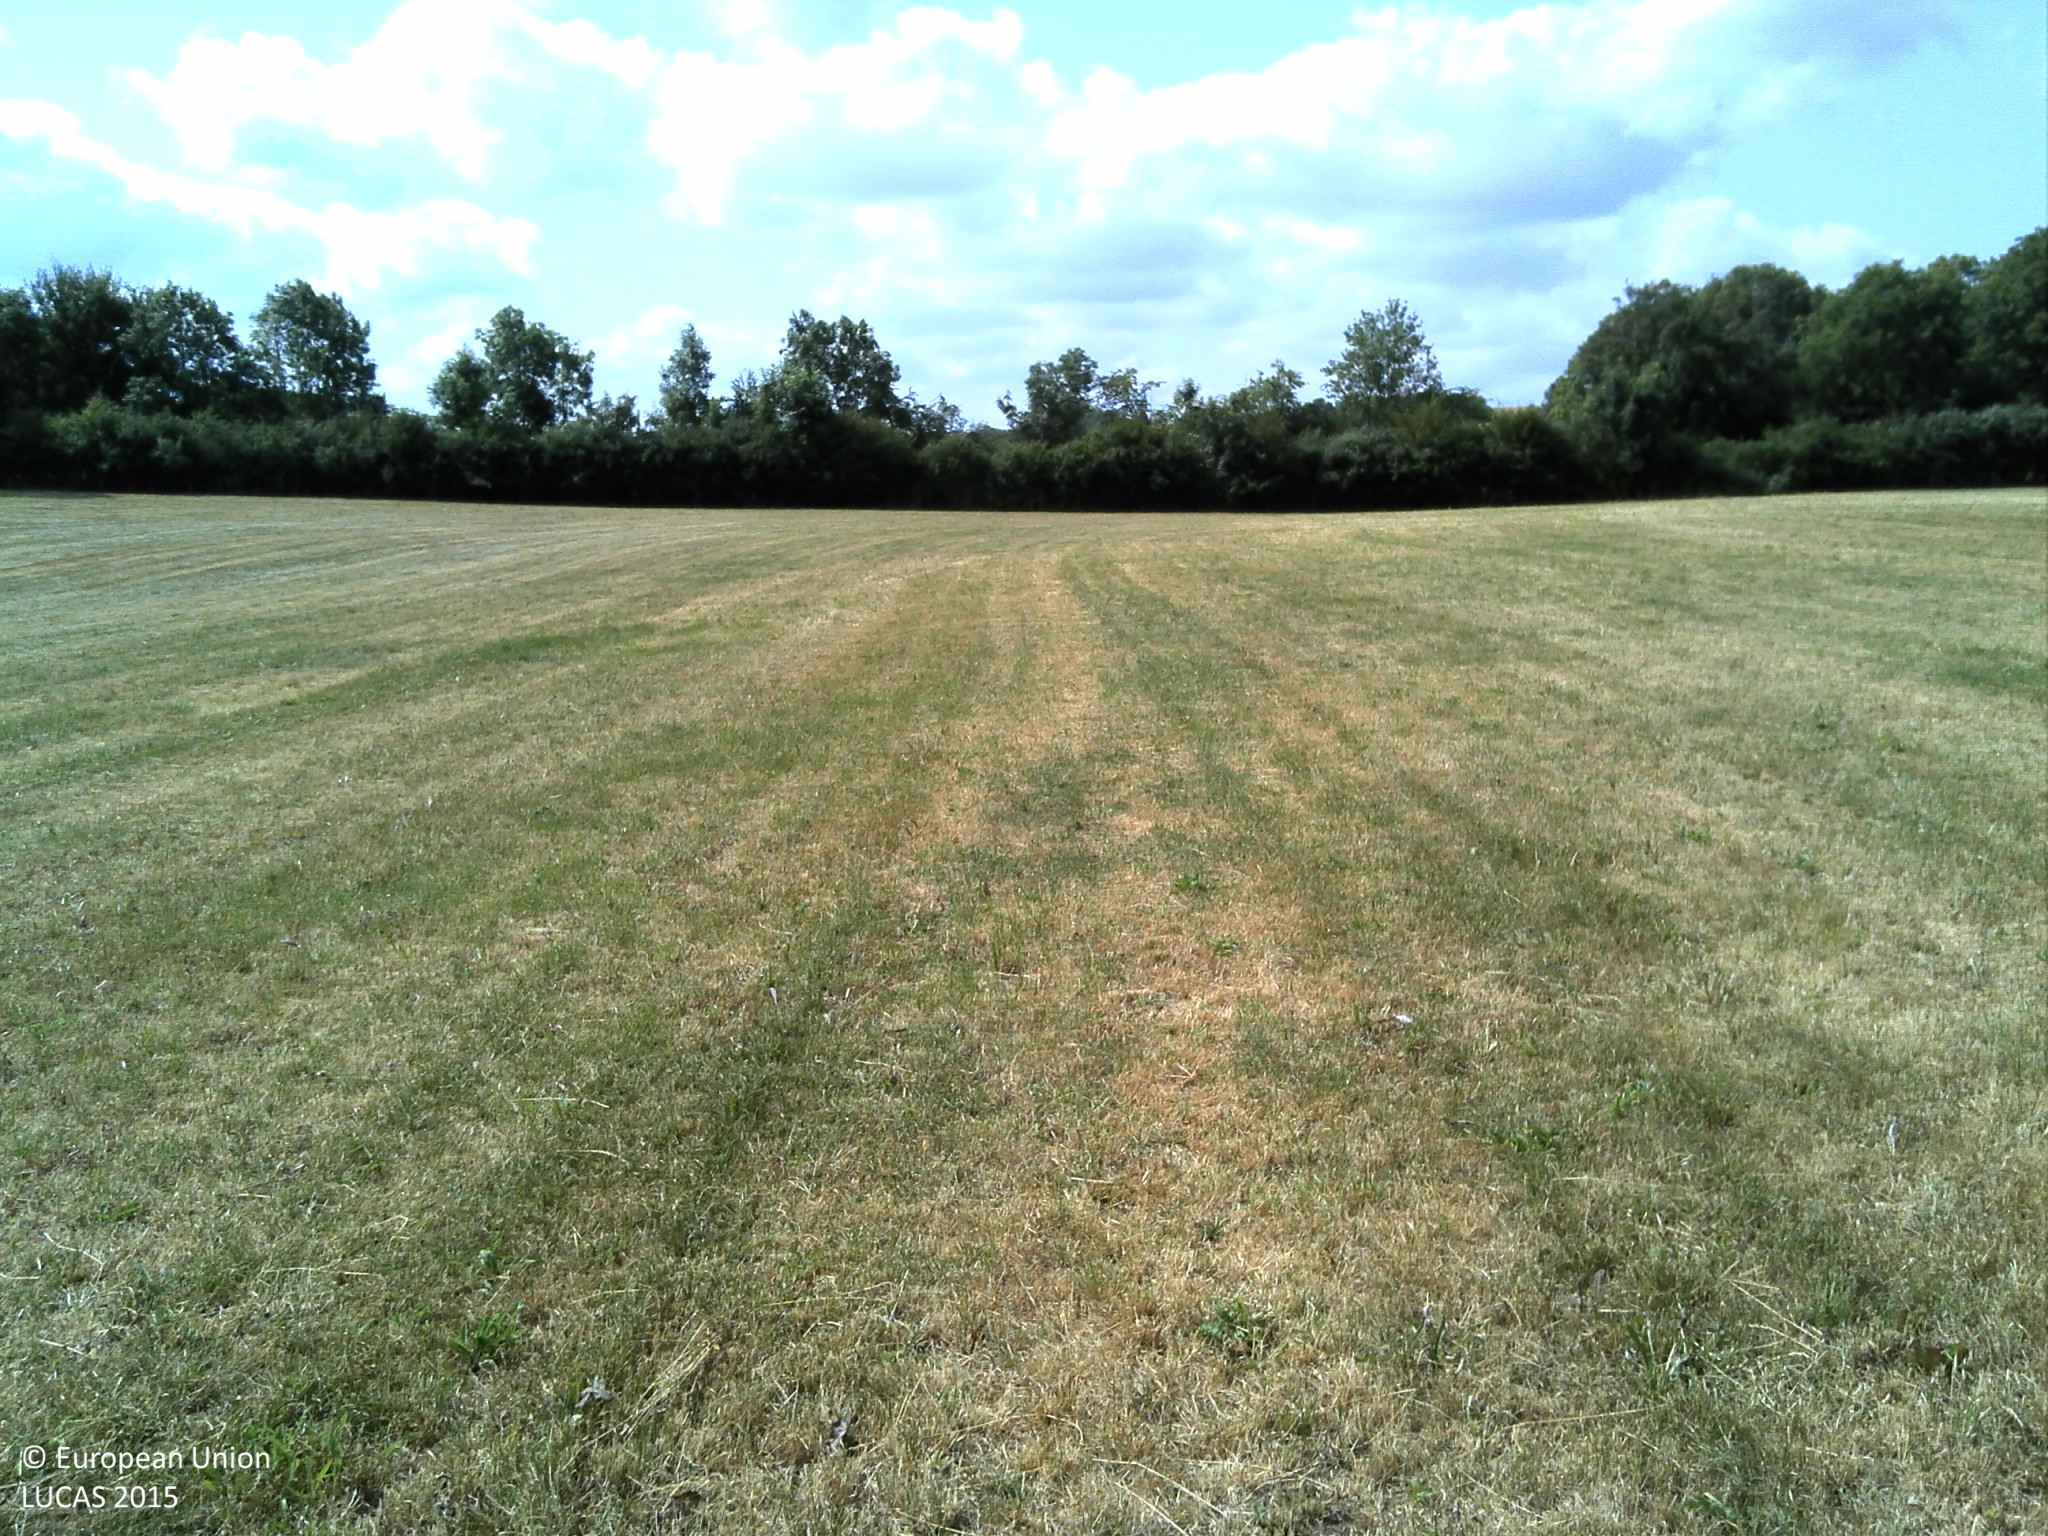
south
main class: Grassland
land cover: Grassland without tree/shrub cover
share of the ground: > 75 %
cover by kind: herbaceous plants 100 %
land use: Agriculture (excluding fallow land and kitchen gardens)
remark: Harvested field
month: July
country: FR
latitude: 48.1778
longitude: 6.2484
